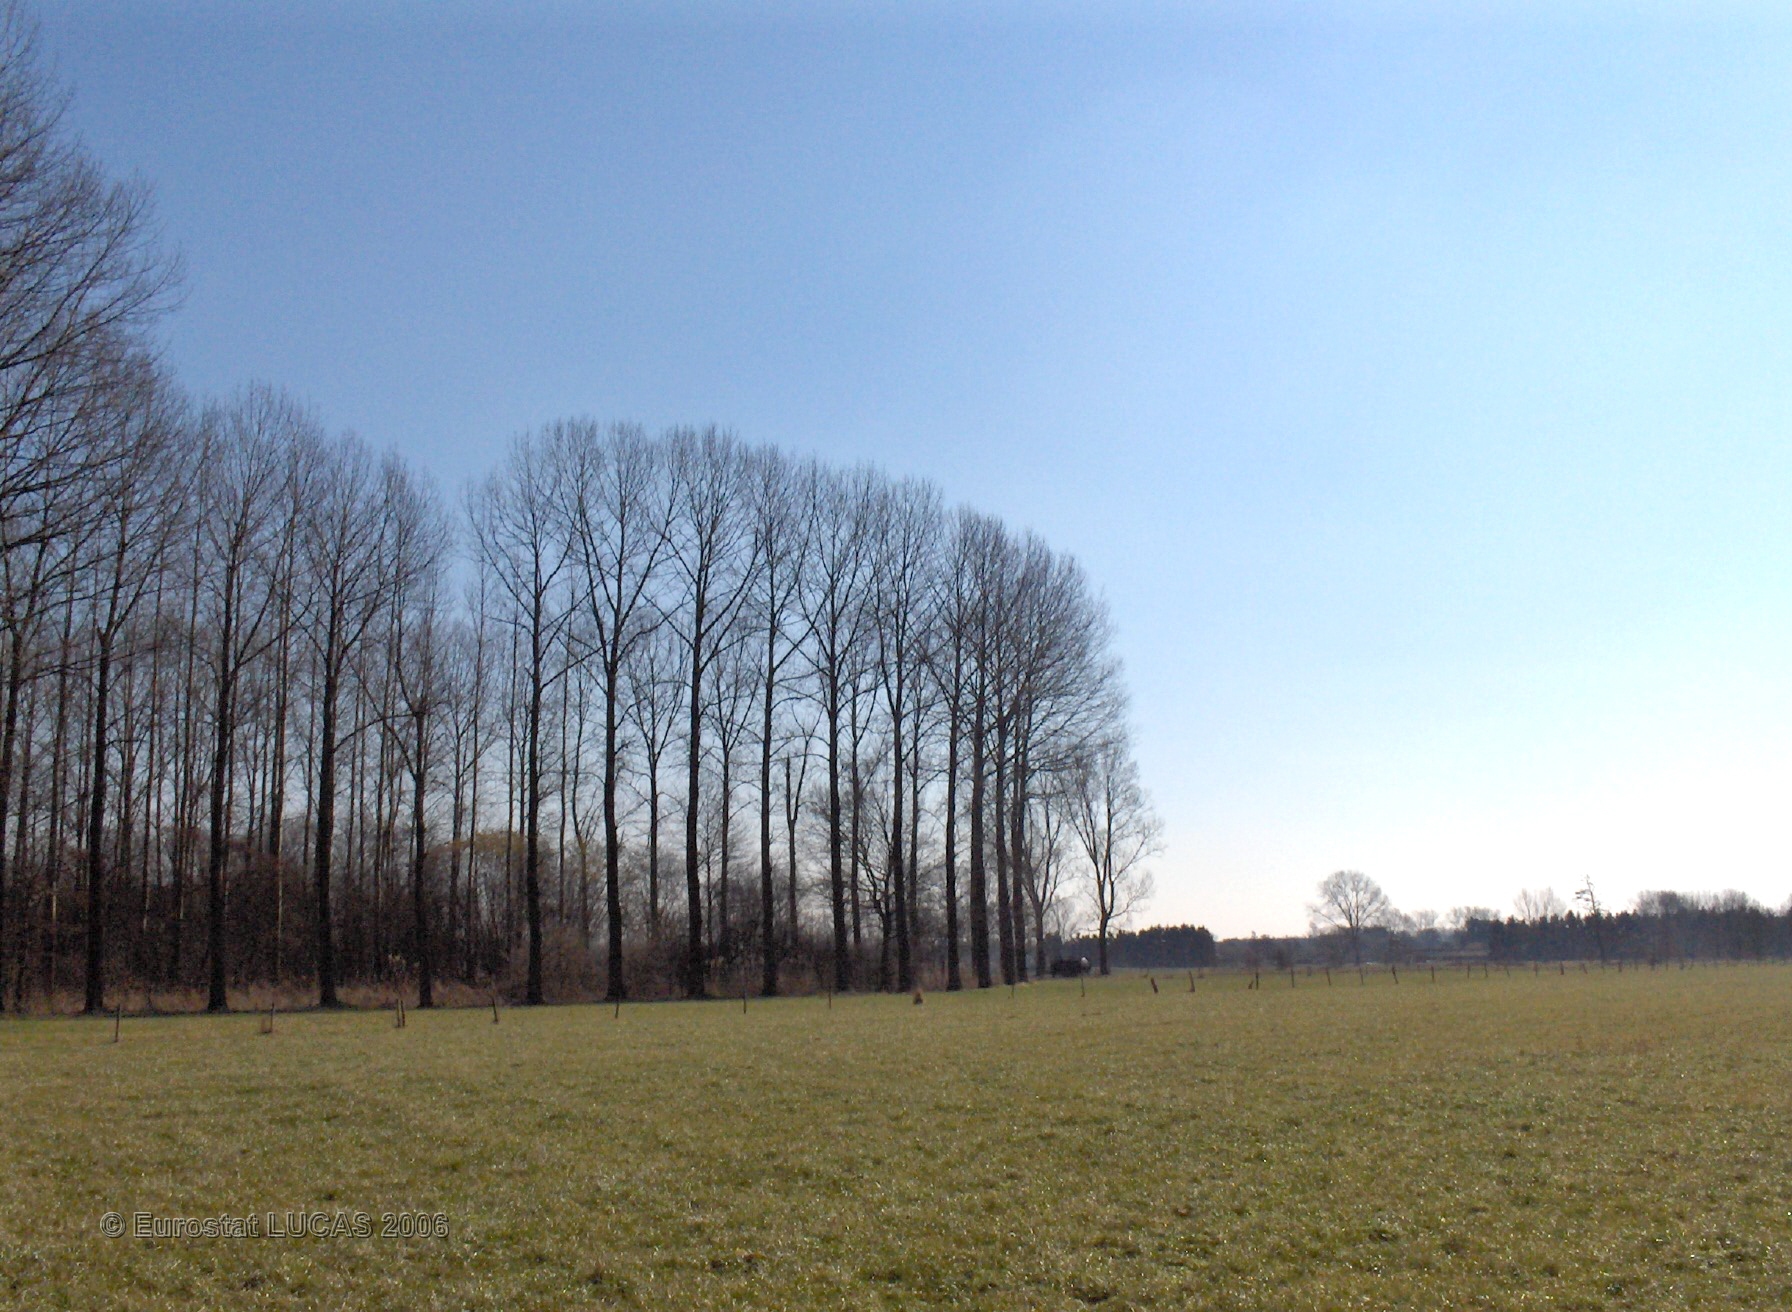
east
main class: Grassland
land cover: Grassland without tree/shrub cover
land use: Agriculture (excluding fallow land and kitchen gardens)
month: March
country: BE
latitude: 50.9669
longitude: 5.2273
